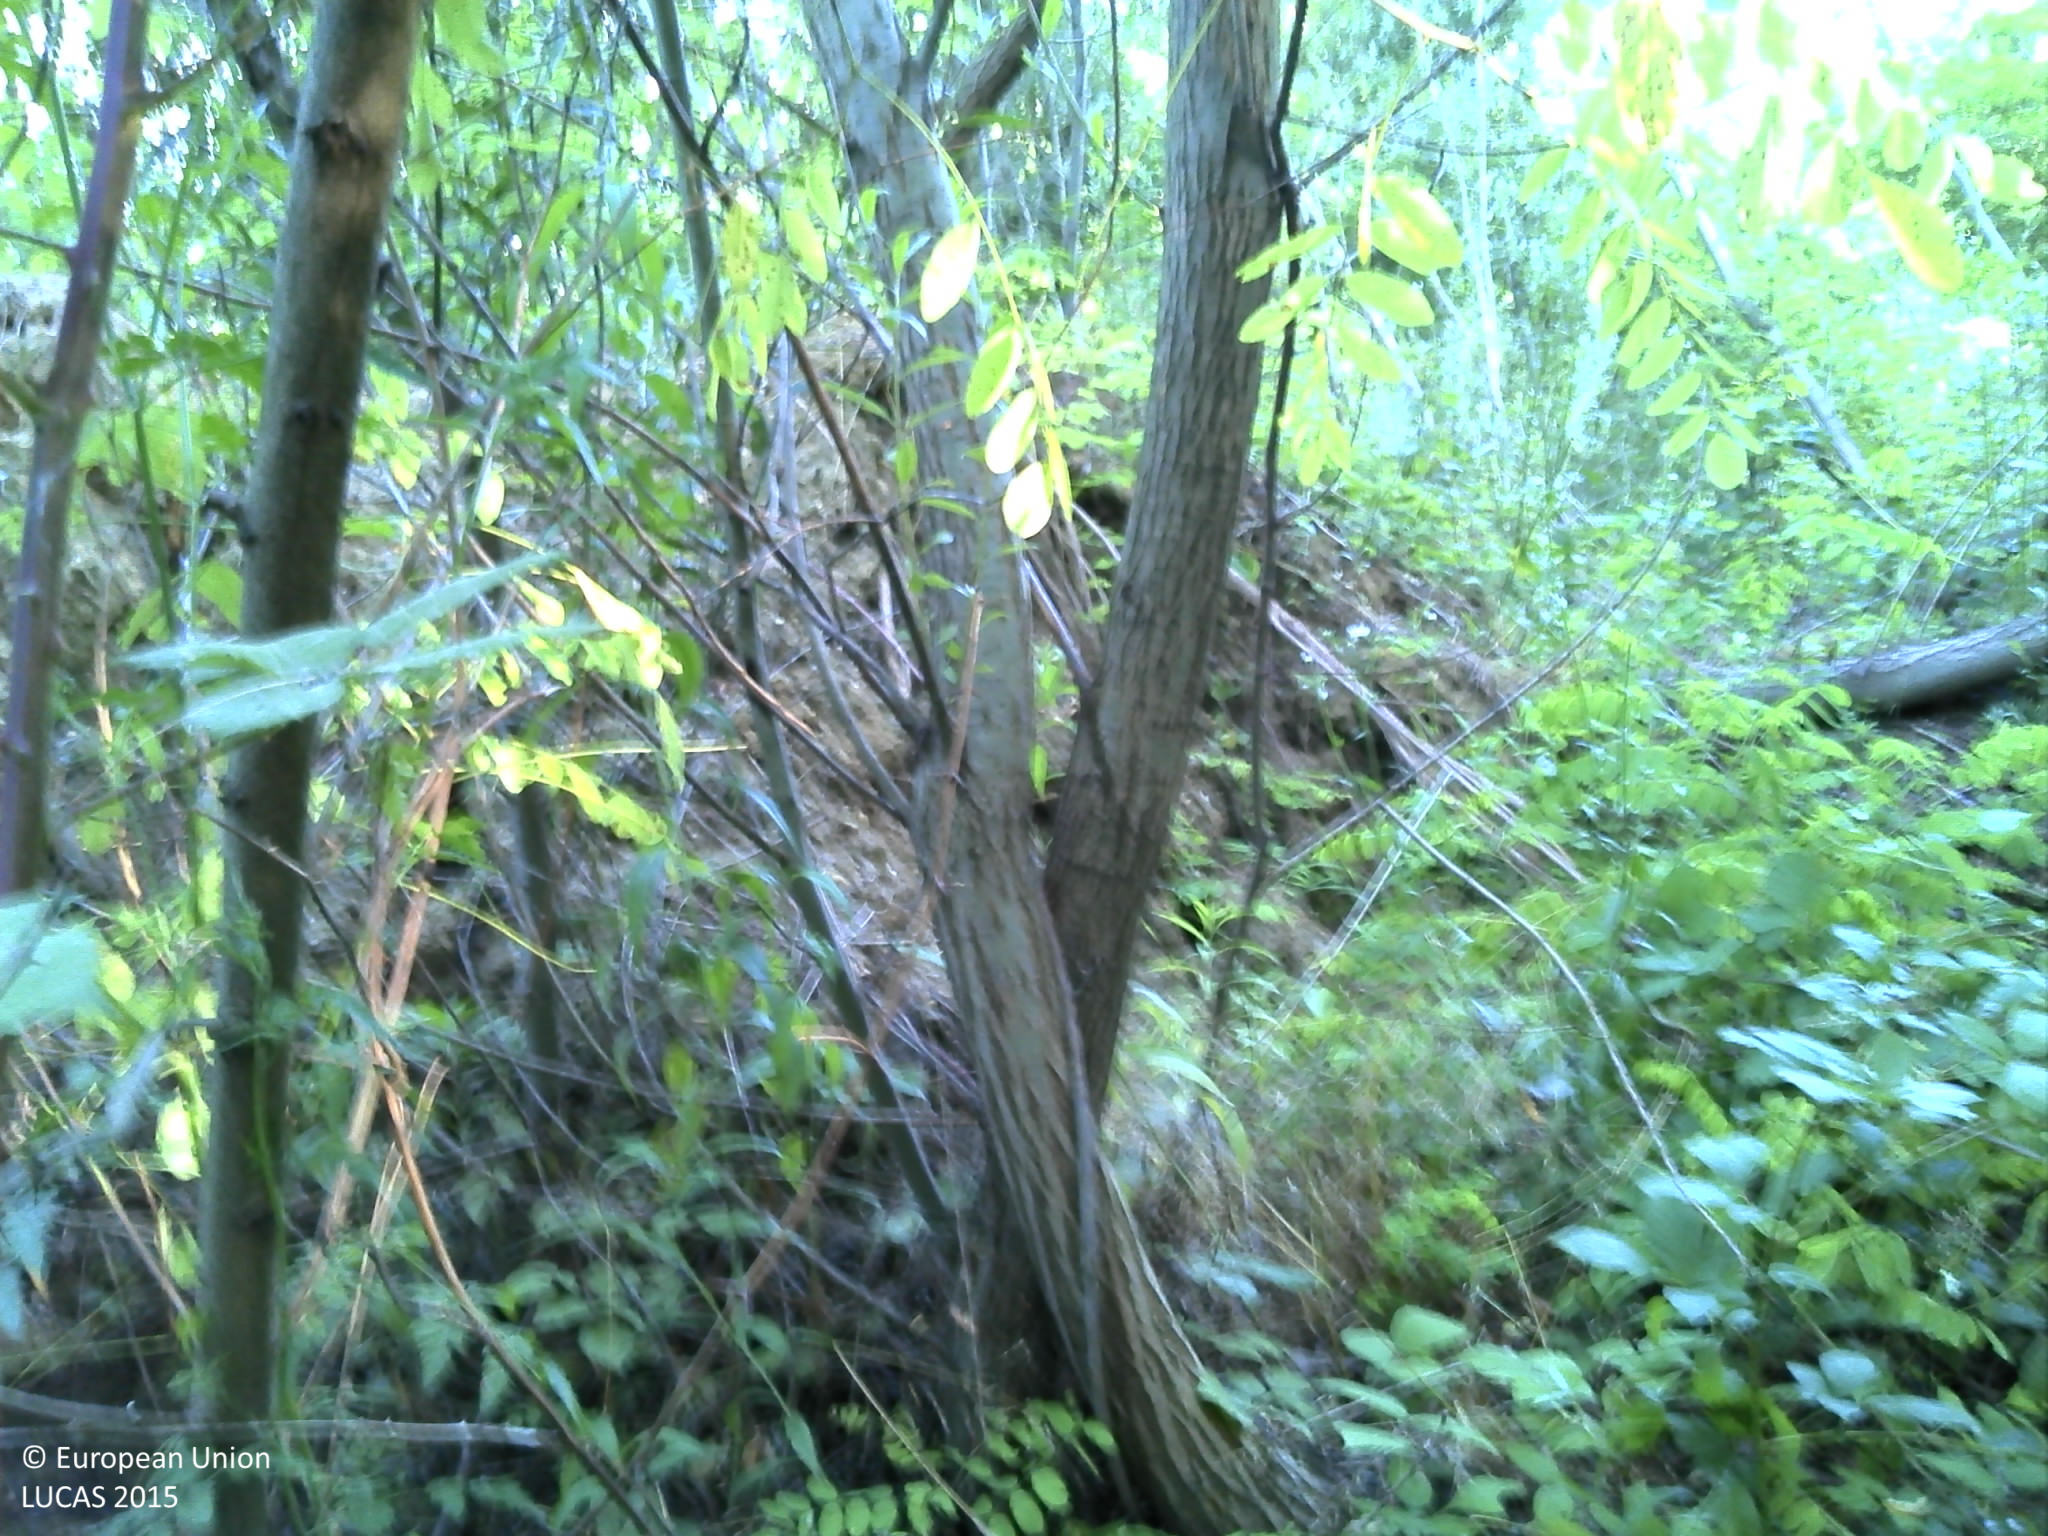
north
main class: Woodland
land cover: Broadleaved woodland
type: acidophilous oak and oak-birch forest
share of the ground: > 75 %
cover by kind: broadleaved forest trees 90 %, shrubs 10 %
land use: Forestry
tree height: < 5 m
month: June
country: HR
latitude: 45.8303
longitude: 17.3010
